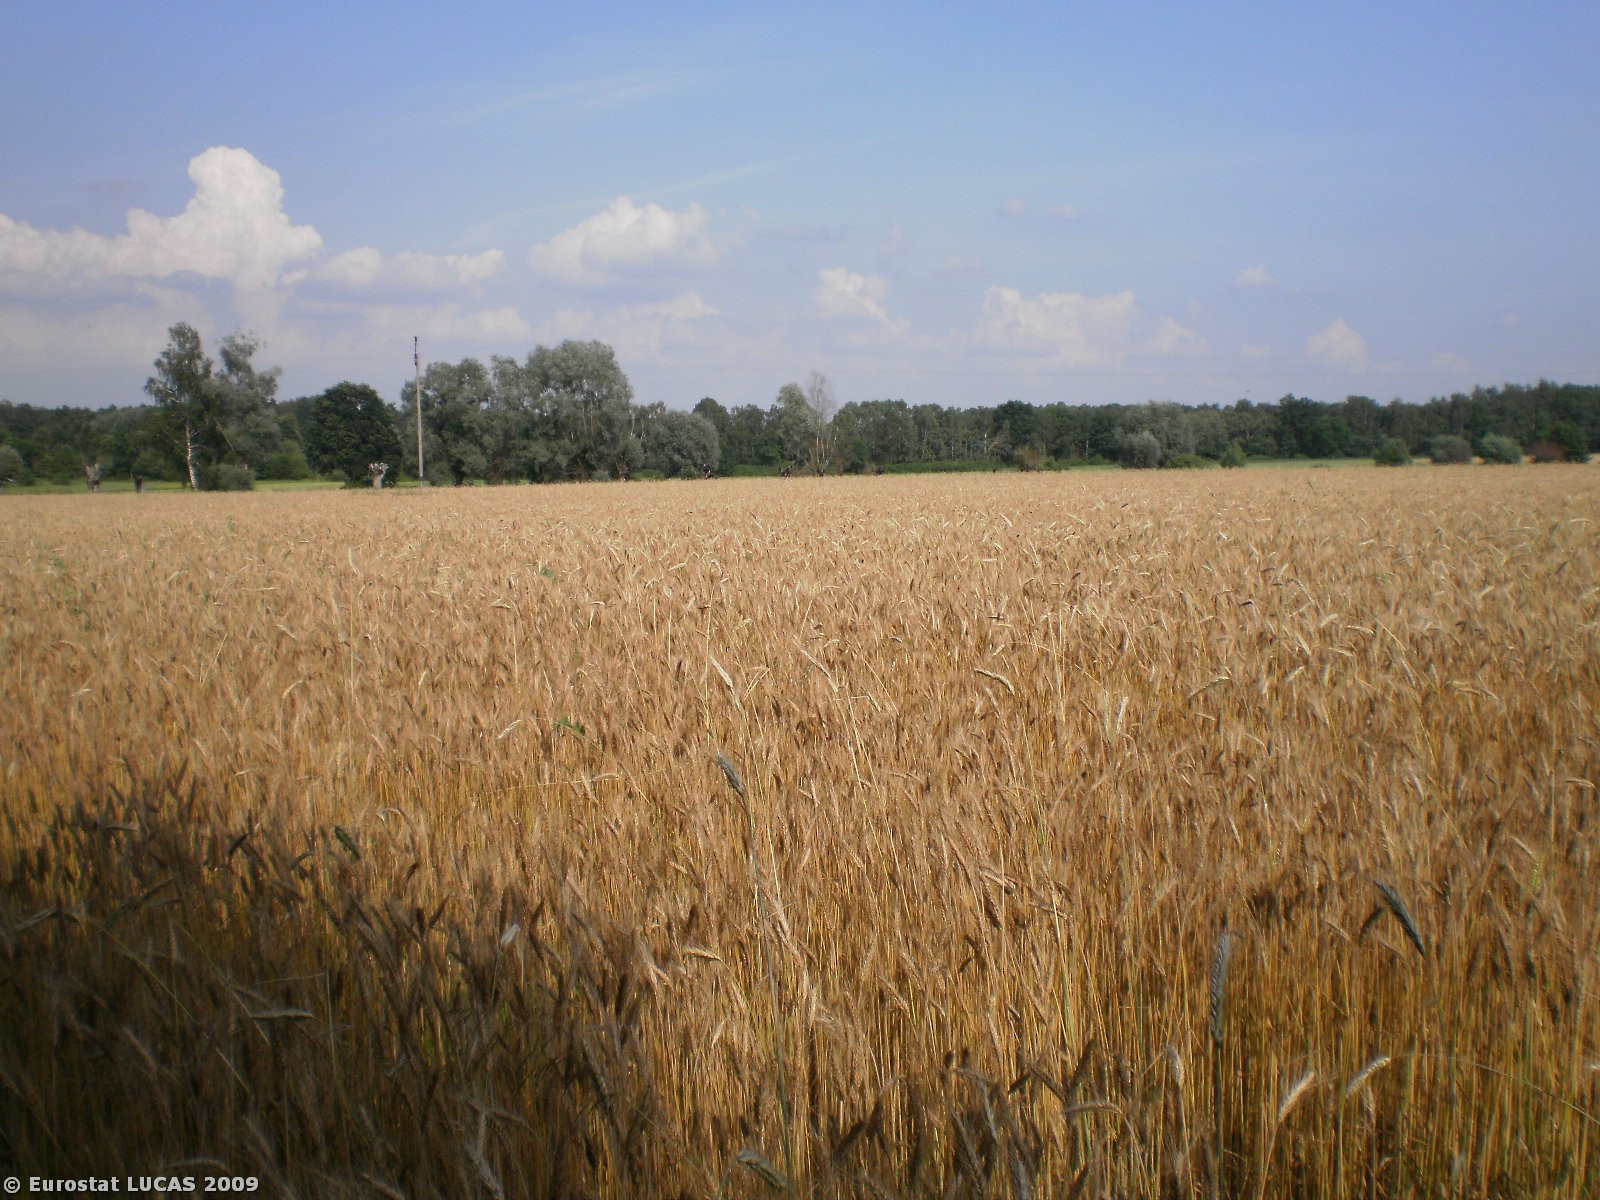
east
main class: Cropland
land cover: Triticale
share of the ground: > 75 %
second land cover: Rye
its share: < 10 %
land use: Agriculture (excluding fallow land and kitchen gardens)
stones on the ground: < 10 %
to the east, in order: Triticale; Rye; Grass margins; Ditches and canals; Lines of trees; Grassland without tree/shrub cover
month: July
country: PL
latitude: 52.7148
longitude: 20.8334
